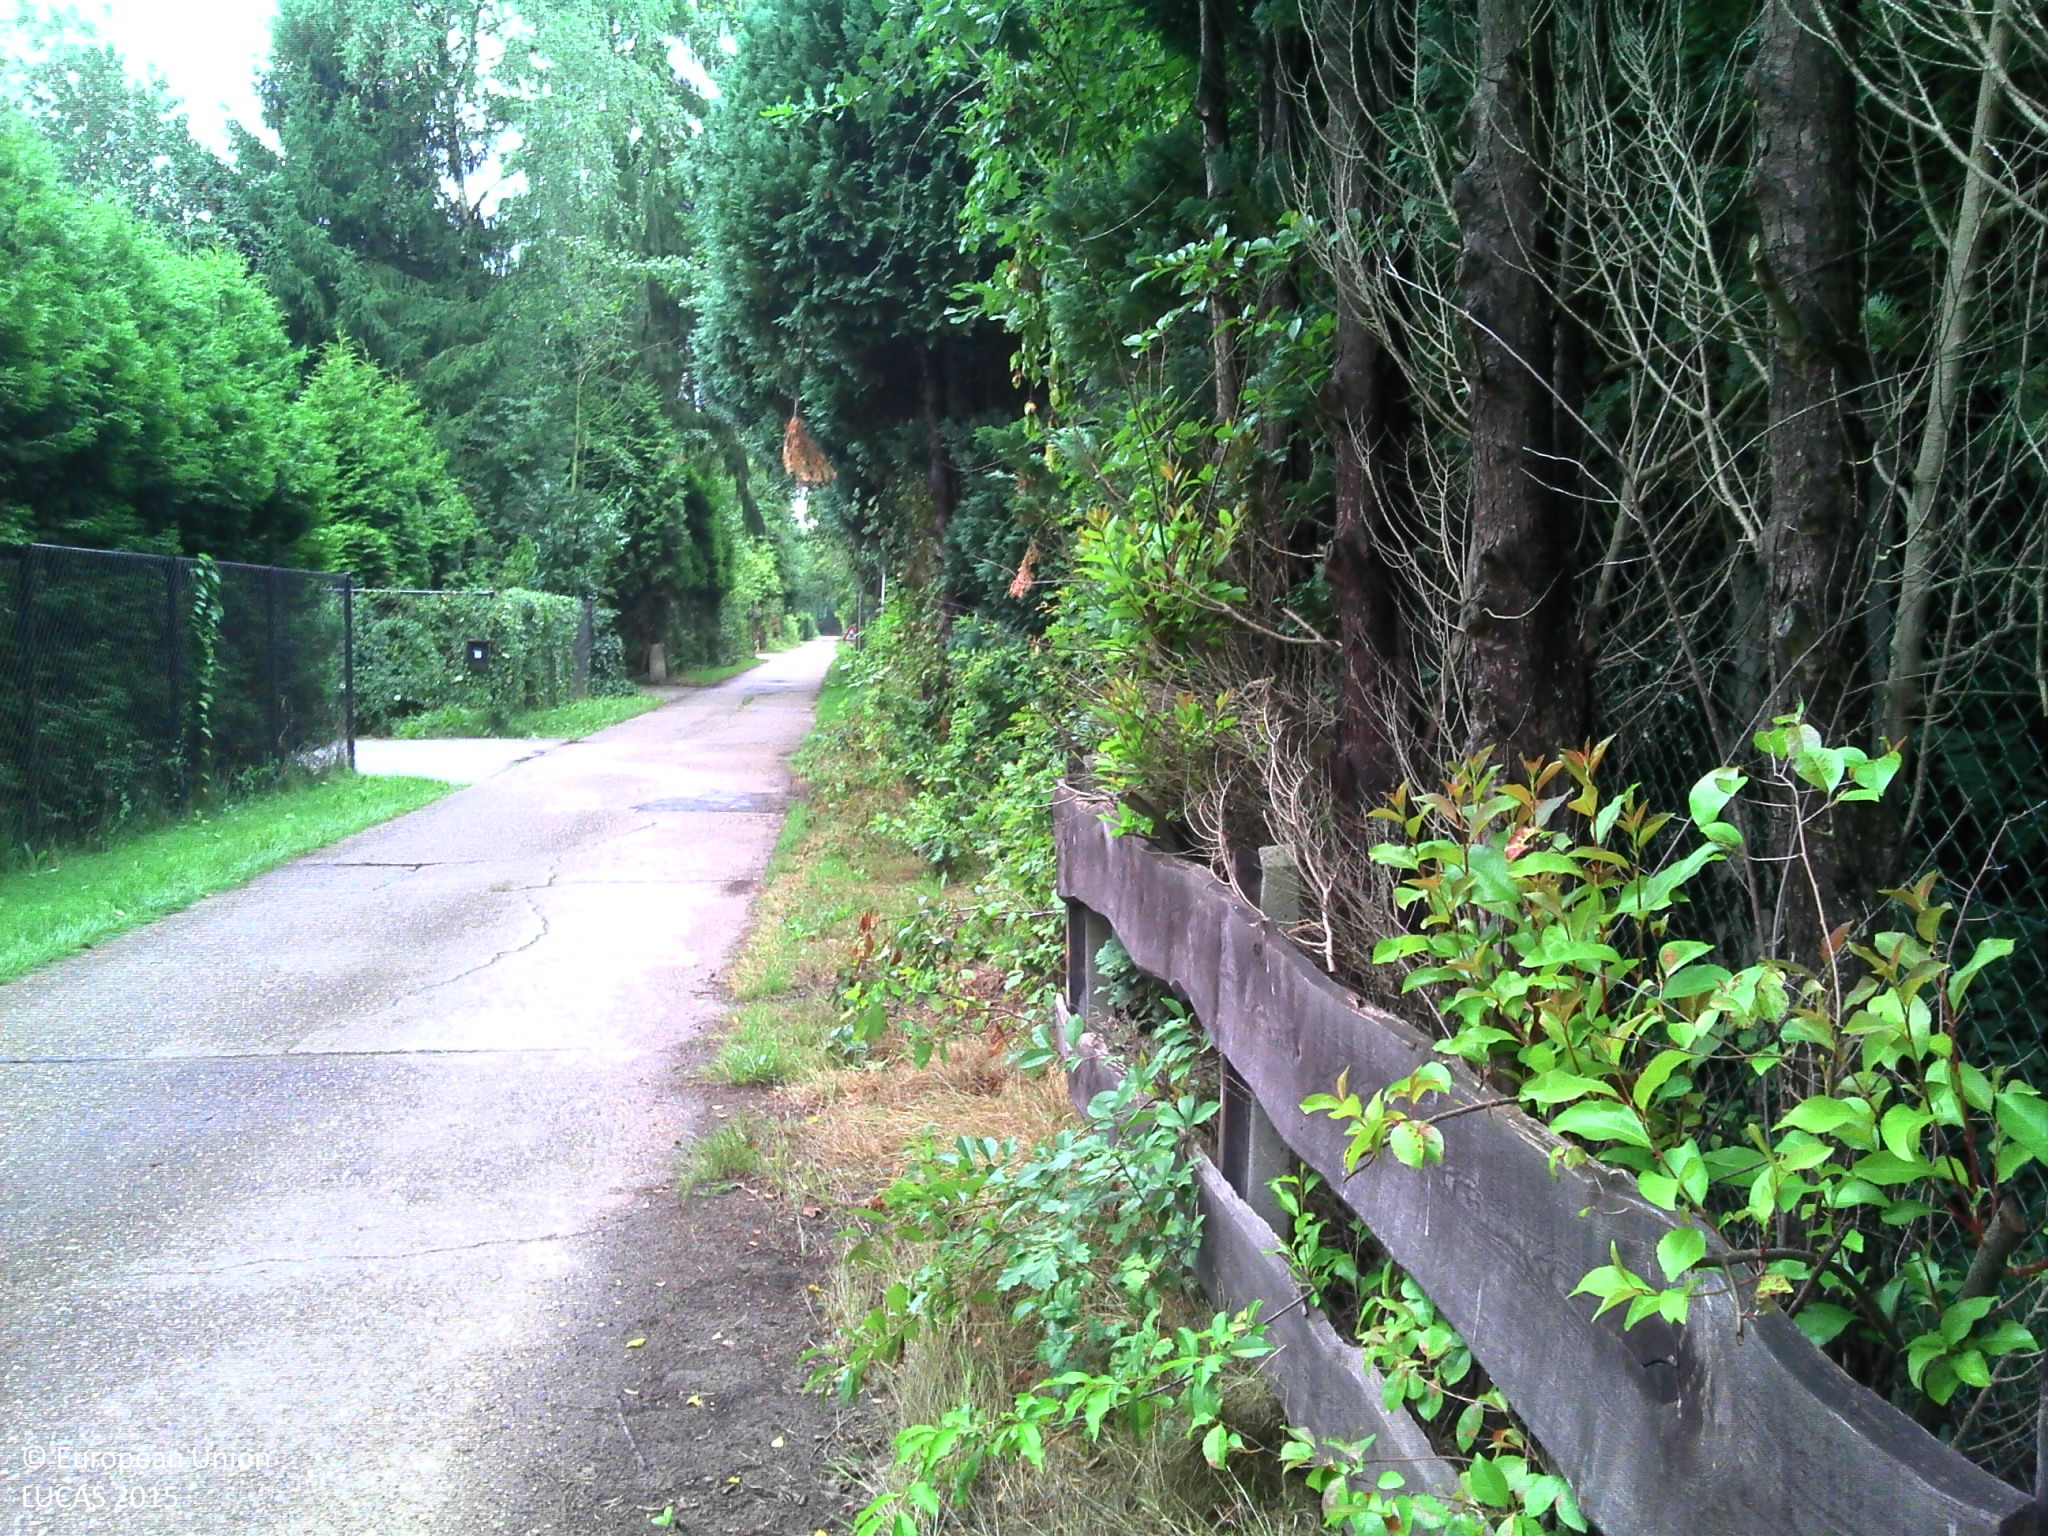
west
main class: Woodland
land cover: Pine dominated coniferous woodland
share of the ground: > 75 %
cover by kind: coniferous forest trees 90 %, broadleaved forest trees 10 %
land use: Residential
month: August
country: BE
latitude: 51.3232
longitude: 5.1328
